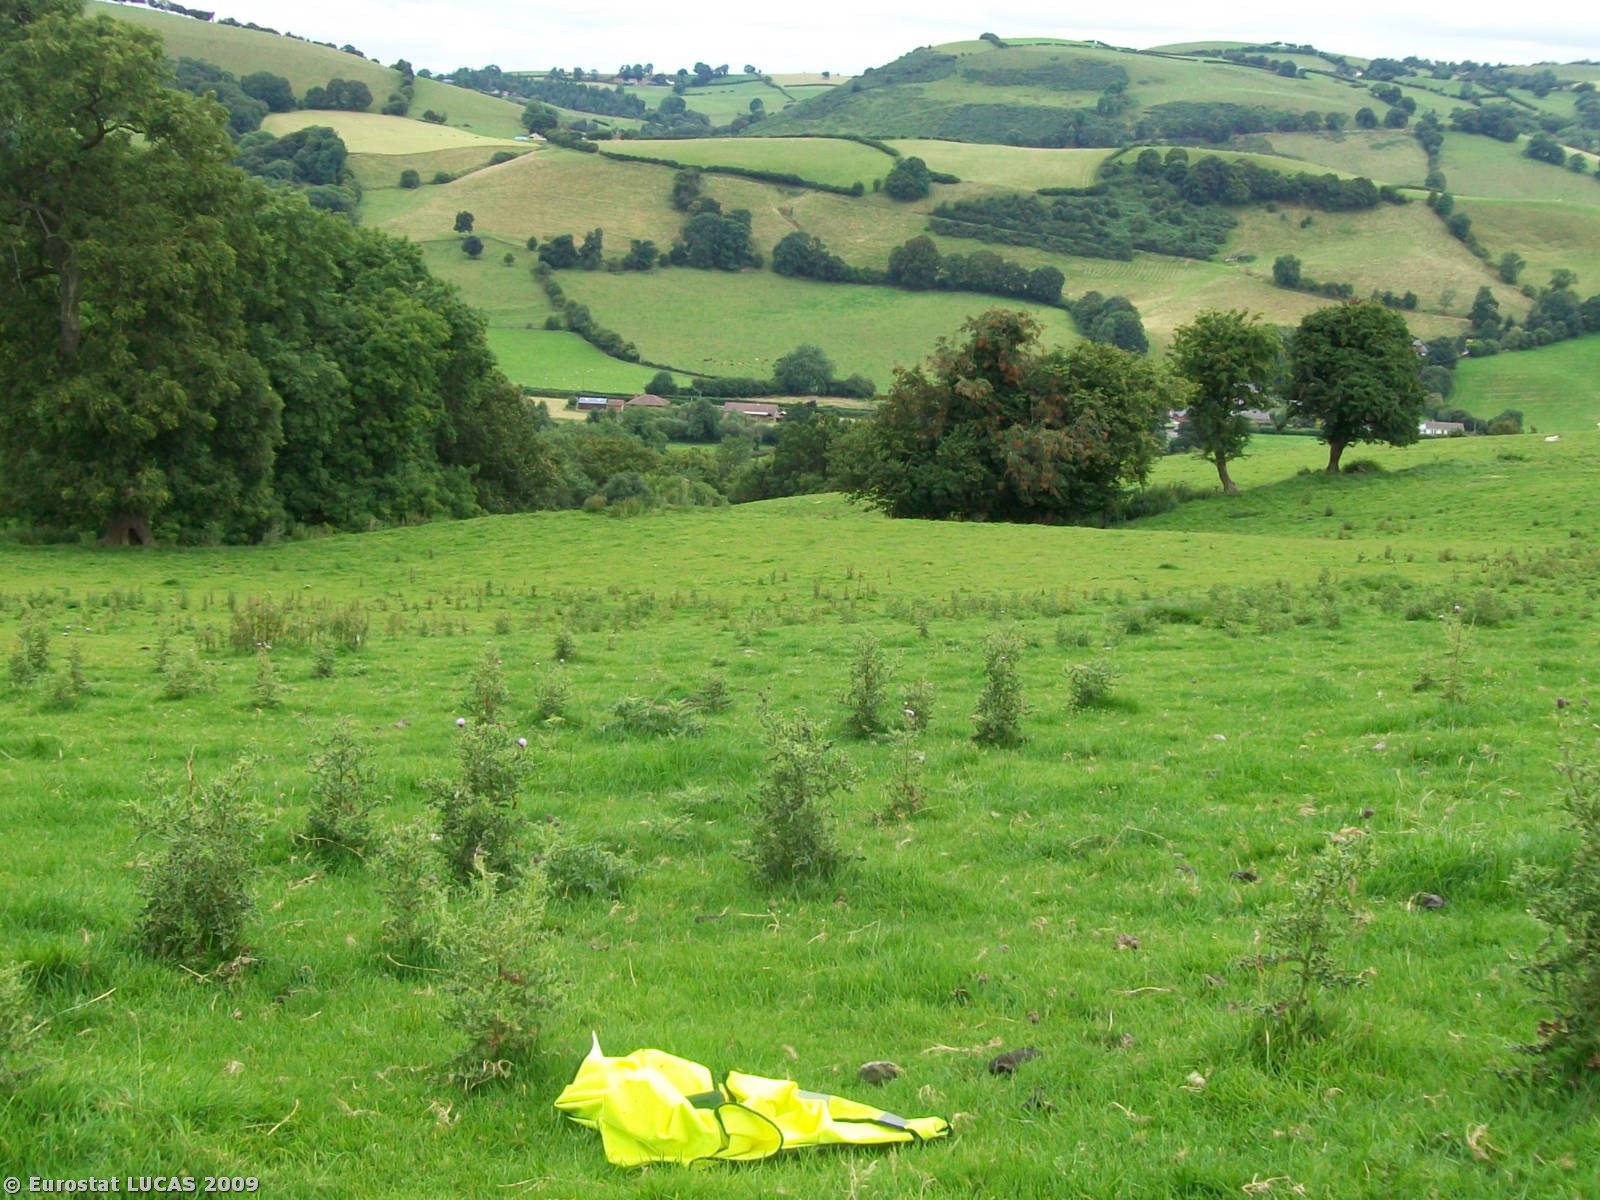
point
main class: Grassland
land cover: Grassland without tree/shrub cover
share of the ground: > 75 %
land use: Agriculture (excluding fallow land and kitchen gardens)
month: August
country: GB
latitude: 52.6096
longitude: -3.2974
